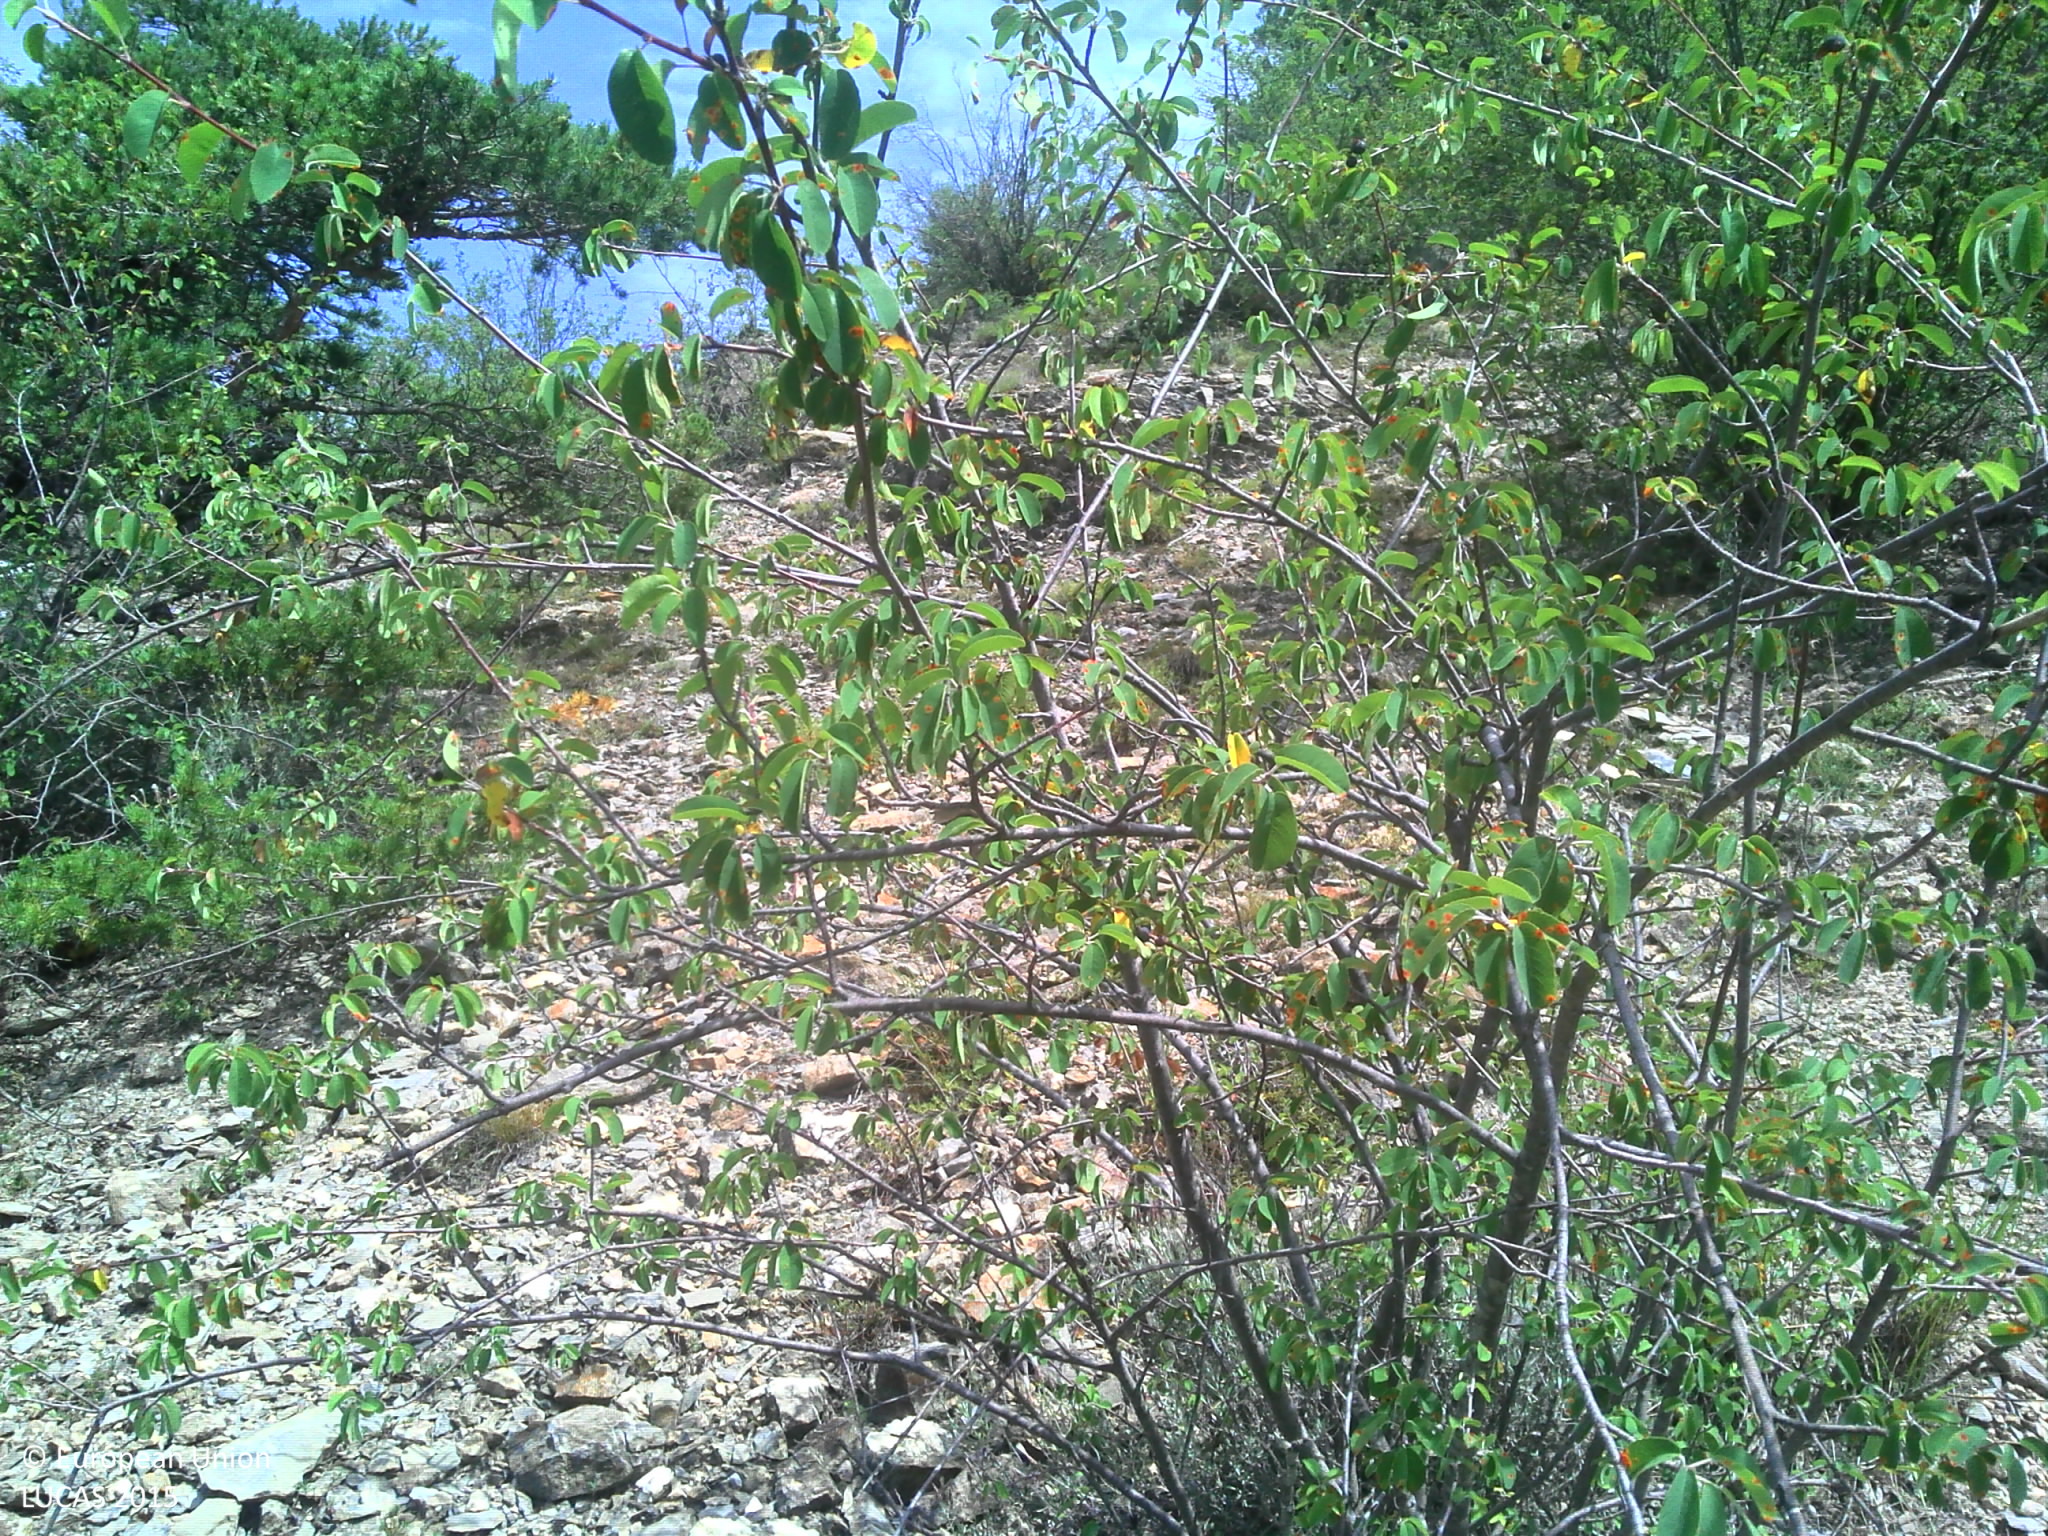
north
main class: Shrubland
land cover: Shrubland with sparse tree cover
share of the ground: 50 - 75 %
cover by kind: shrubs 50 %, unconsolidated bare surface 25 %, herbaceous plants 20 %, coniferous forest trees 5 %
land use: Semi-natural and natural areas not in use
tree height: < 5 m
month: July
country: FR
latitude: 44.4651
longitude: 6.2987
